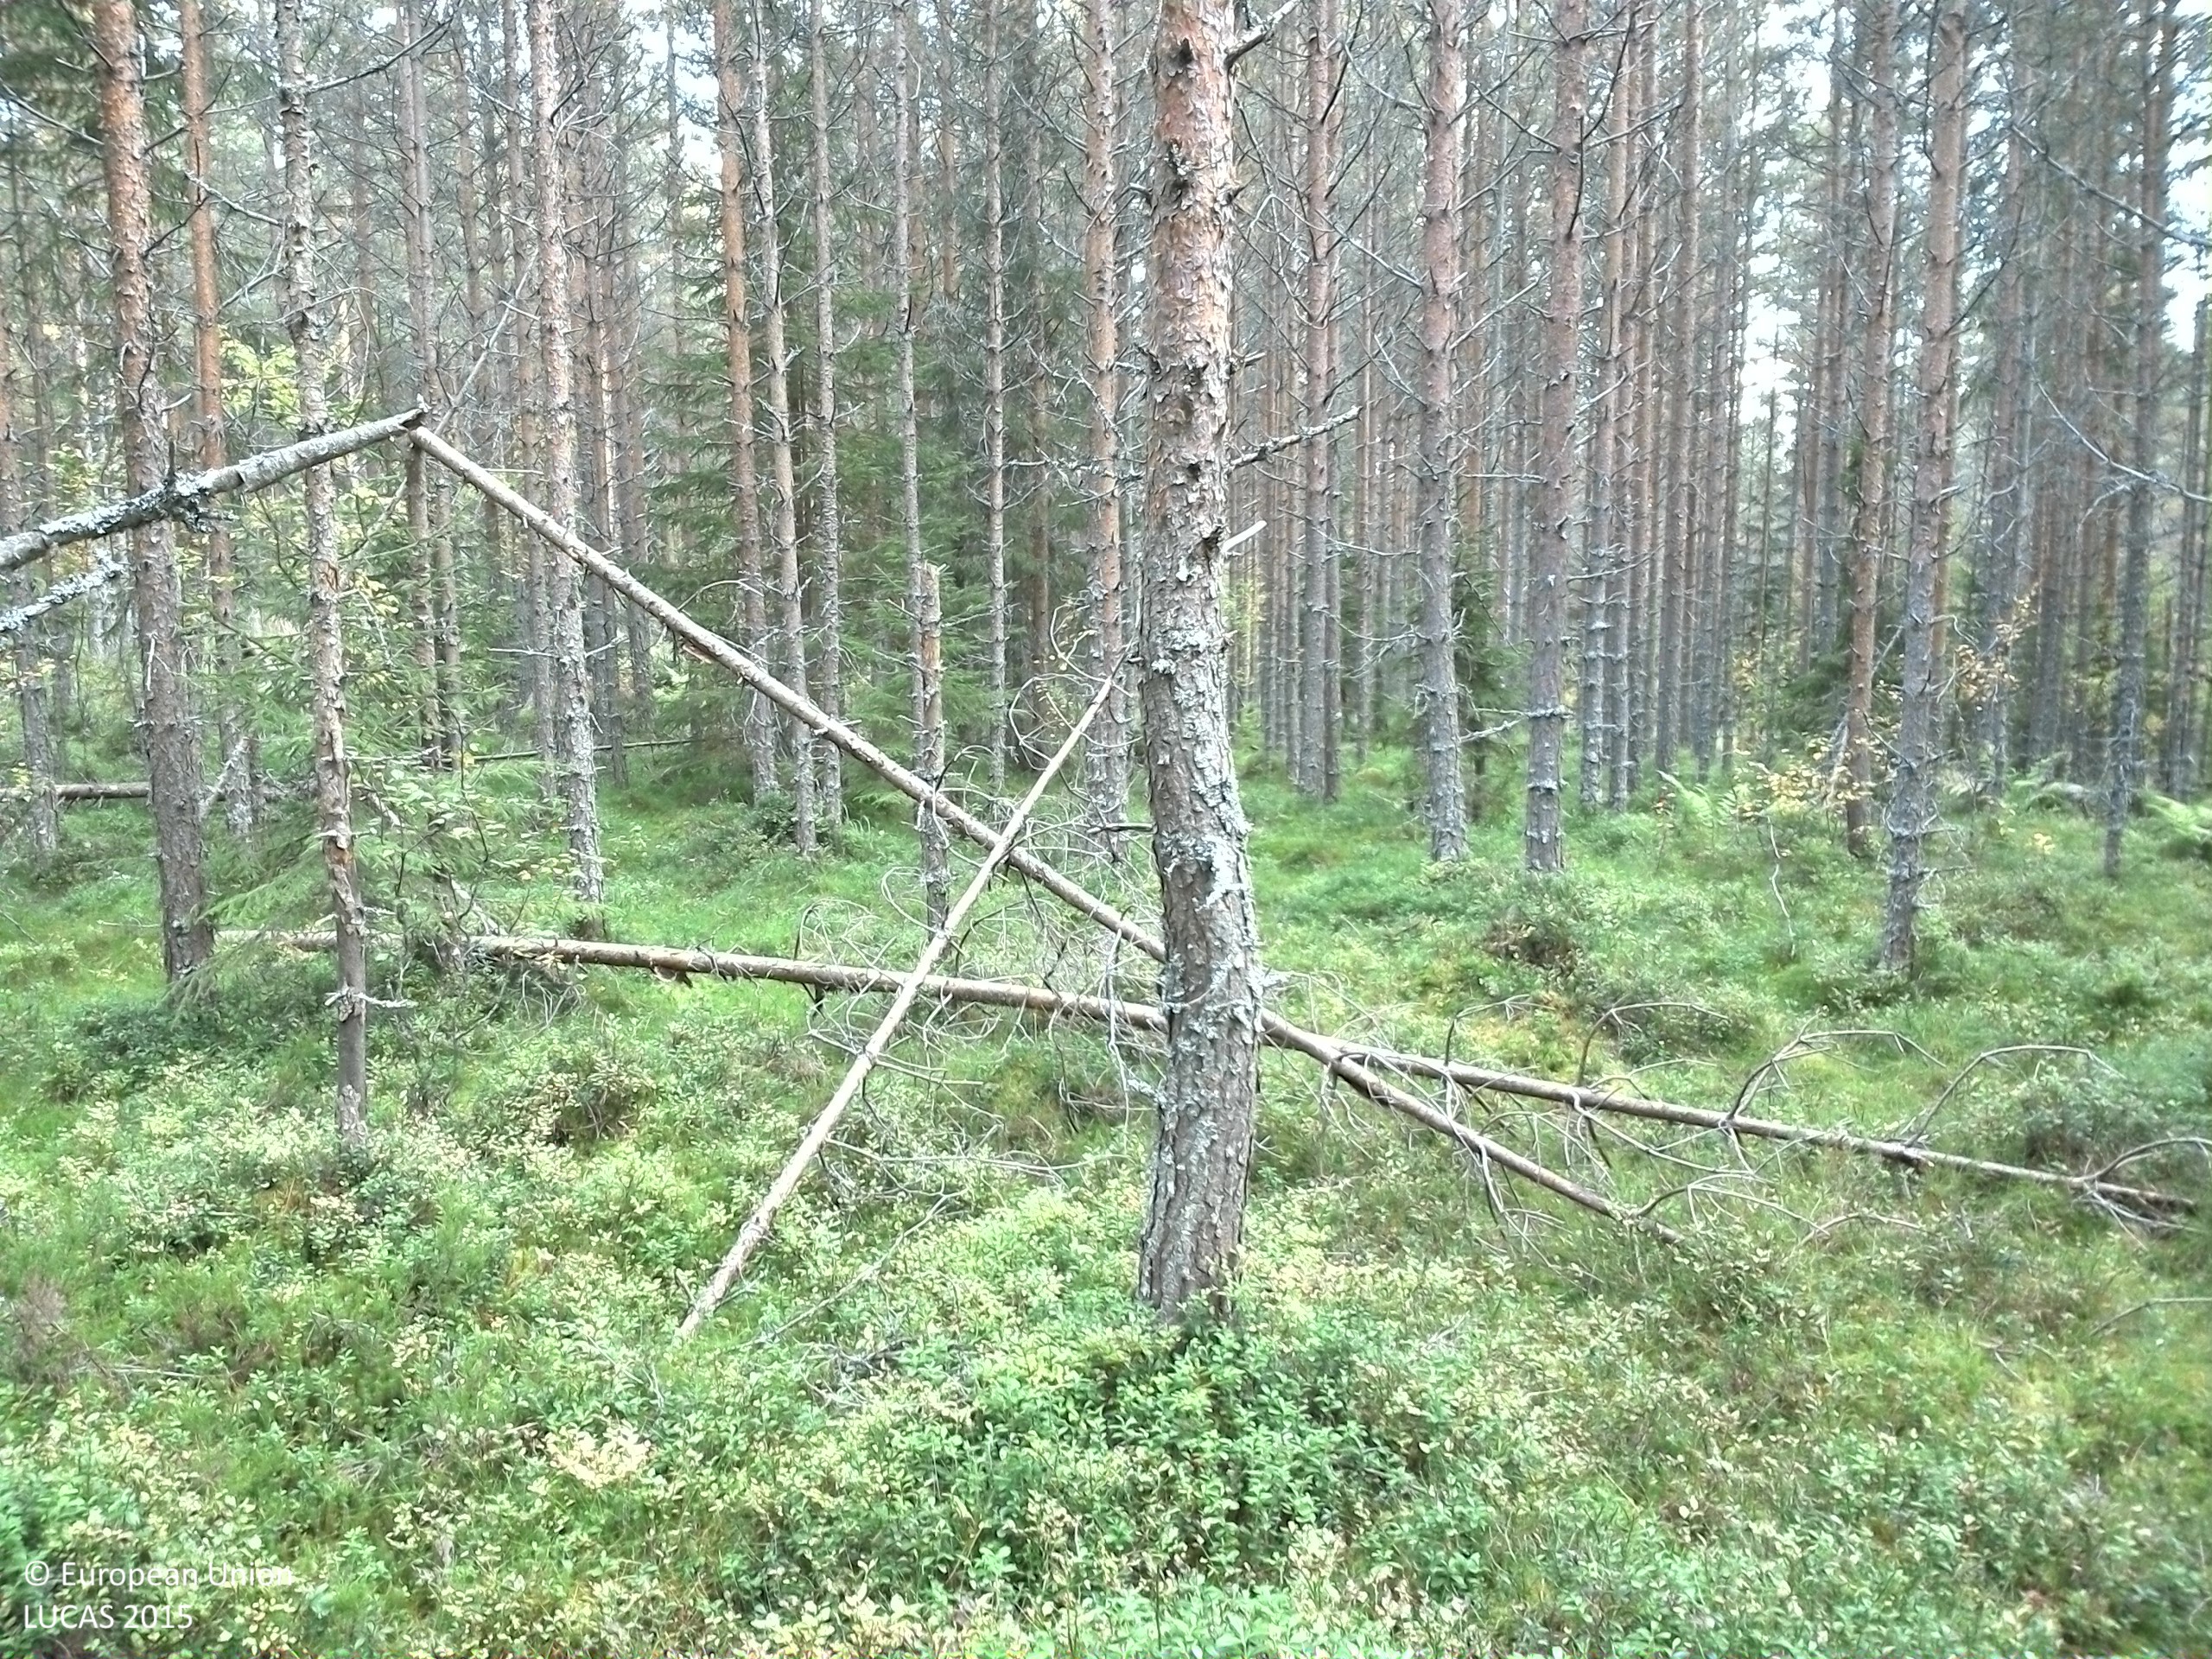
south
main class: Woodland
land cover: Pine dominated coniferous woodland
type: boreal forest
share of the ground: 50 - 75 %
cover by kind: coniferous forest trees 60 %, shrubs 25 %, lichens and mosses 15 %
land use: Forestry
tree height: > 5 m
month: September
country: SE
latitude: 61.3030
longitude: 15.4547
